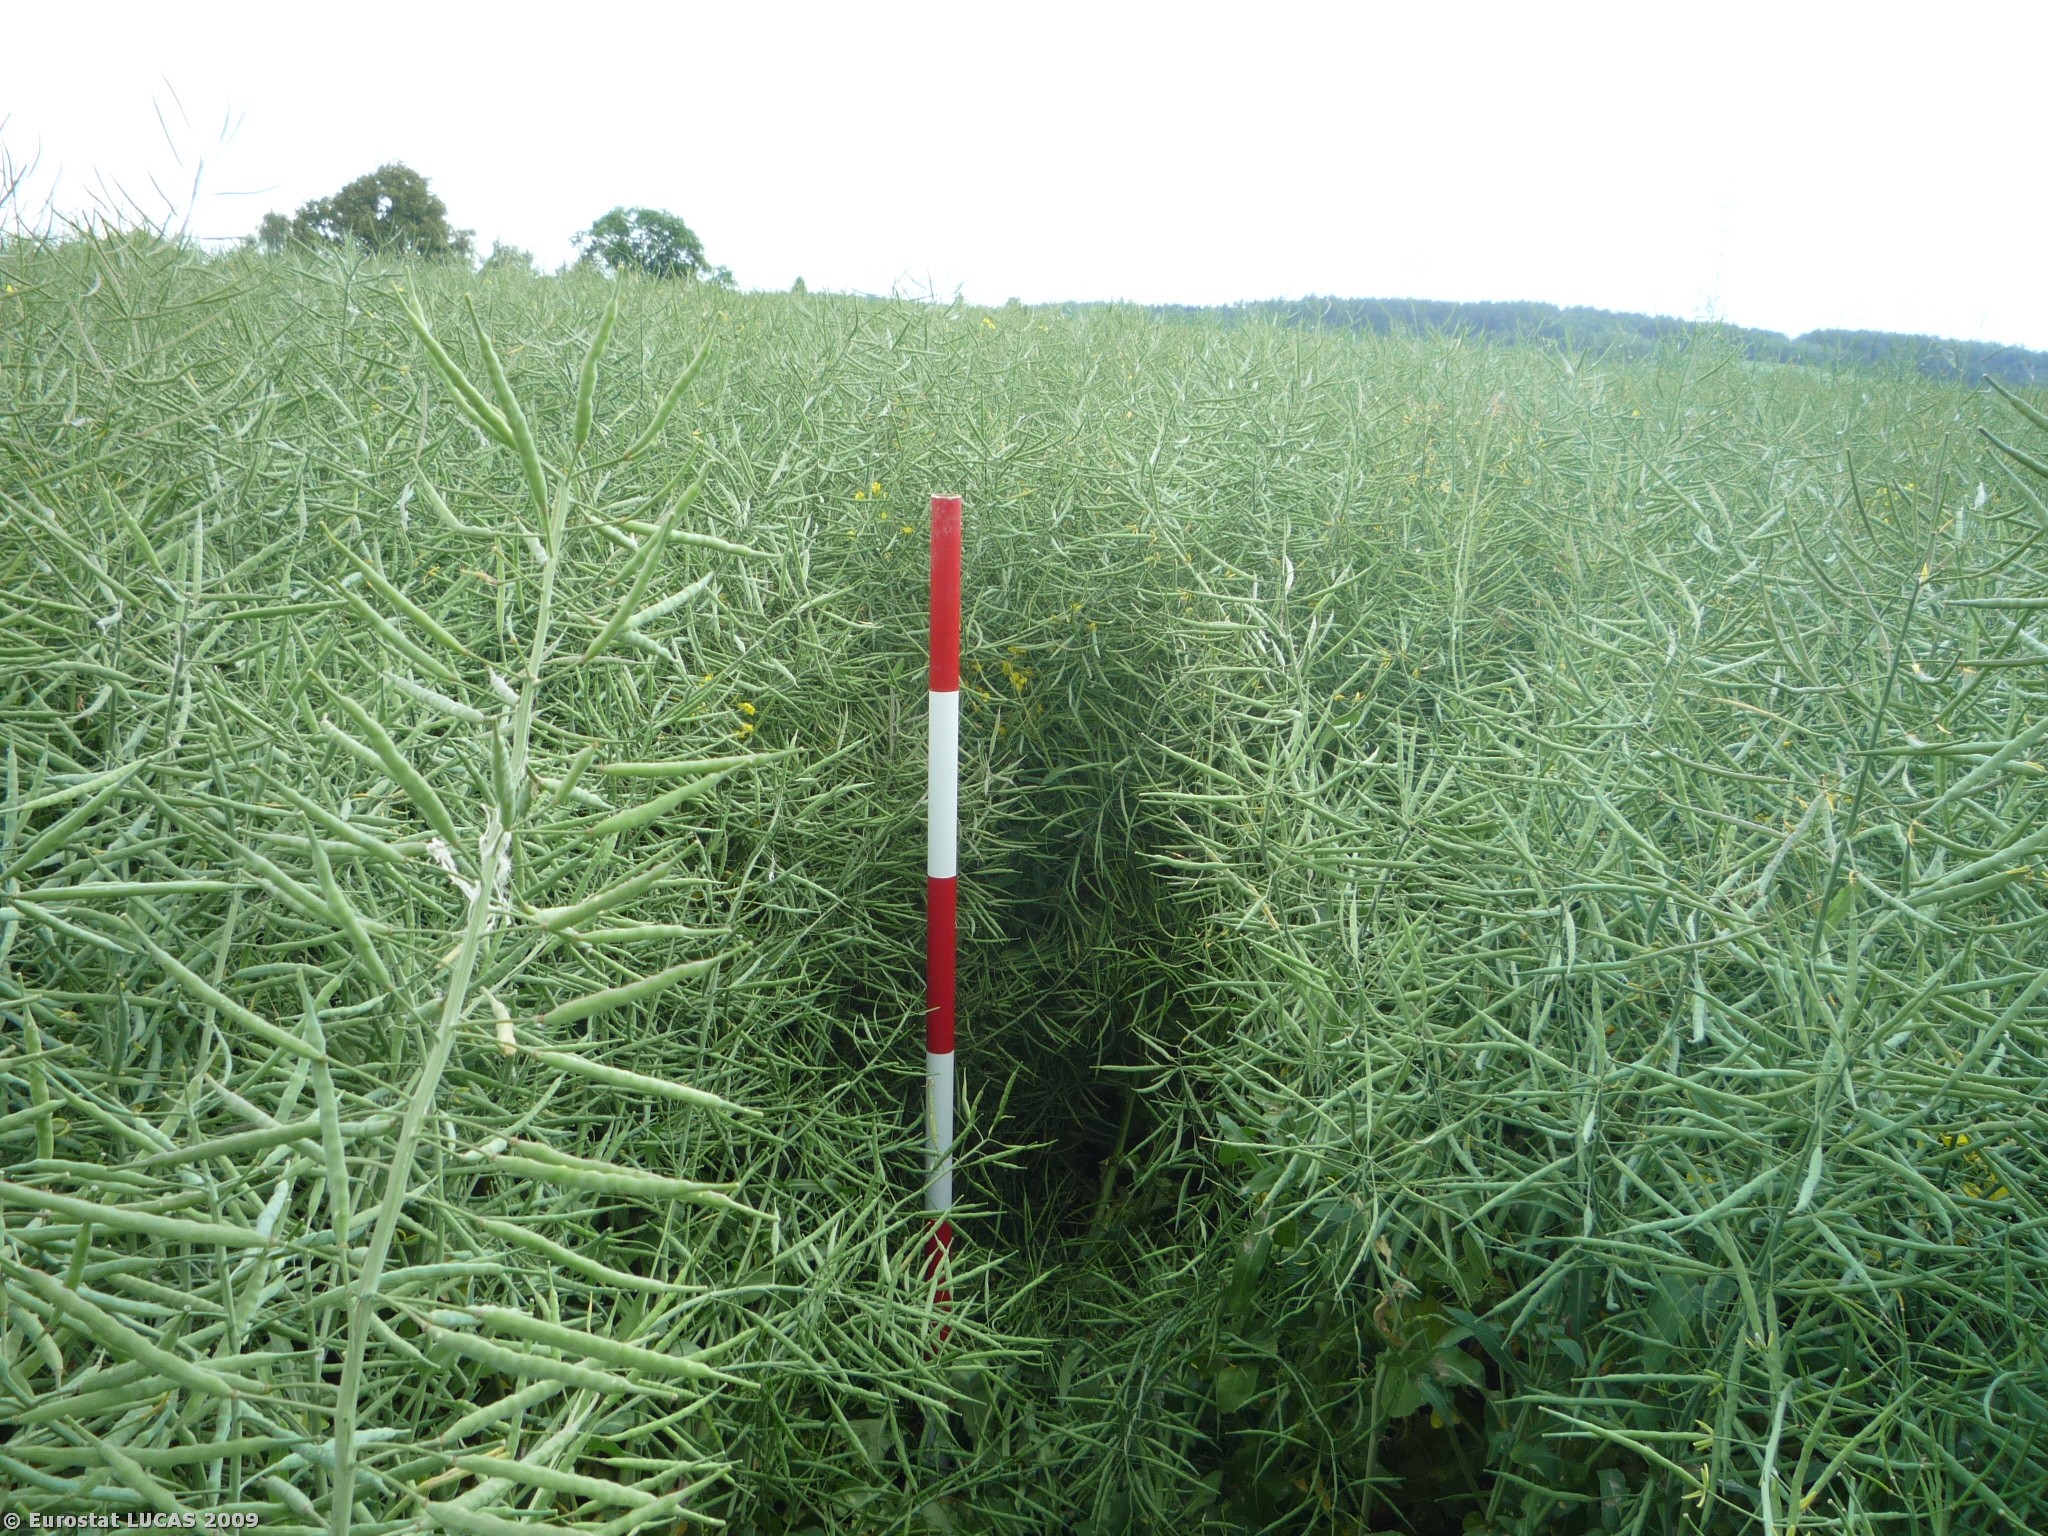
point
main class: Cropland
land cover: Rape and turnip rape
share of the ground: > 75 %
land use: Agriculture (excluding fallow land and kitchen gardens)
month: June
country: CZ
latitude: 50.3785
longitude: 15.8128
